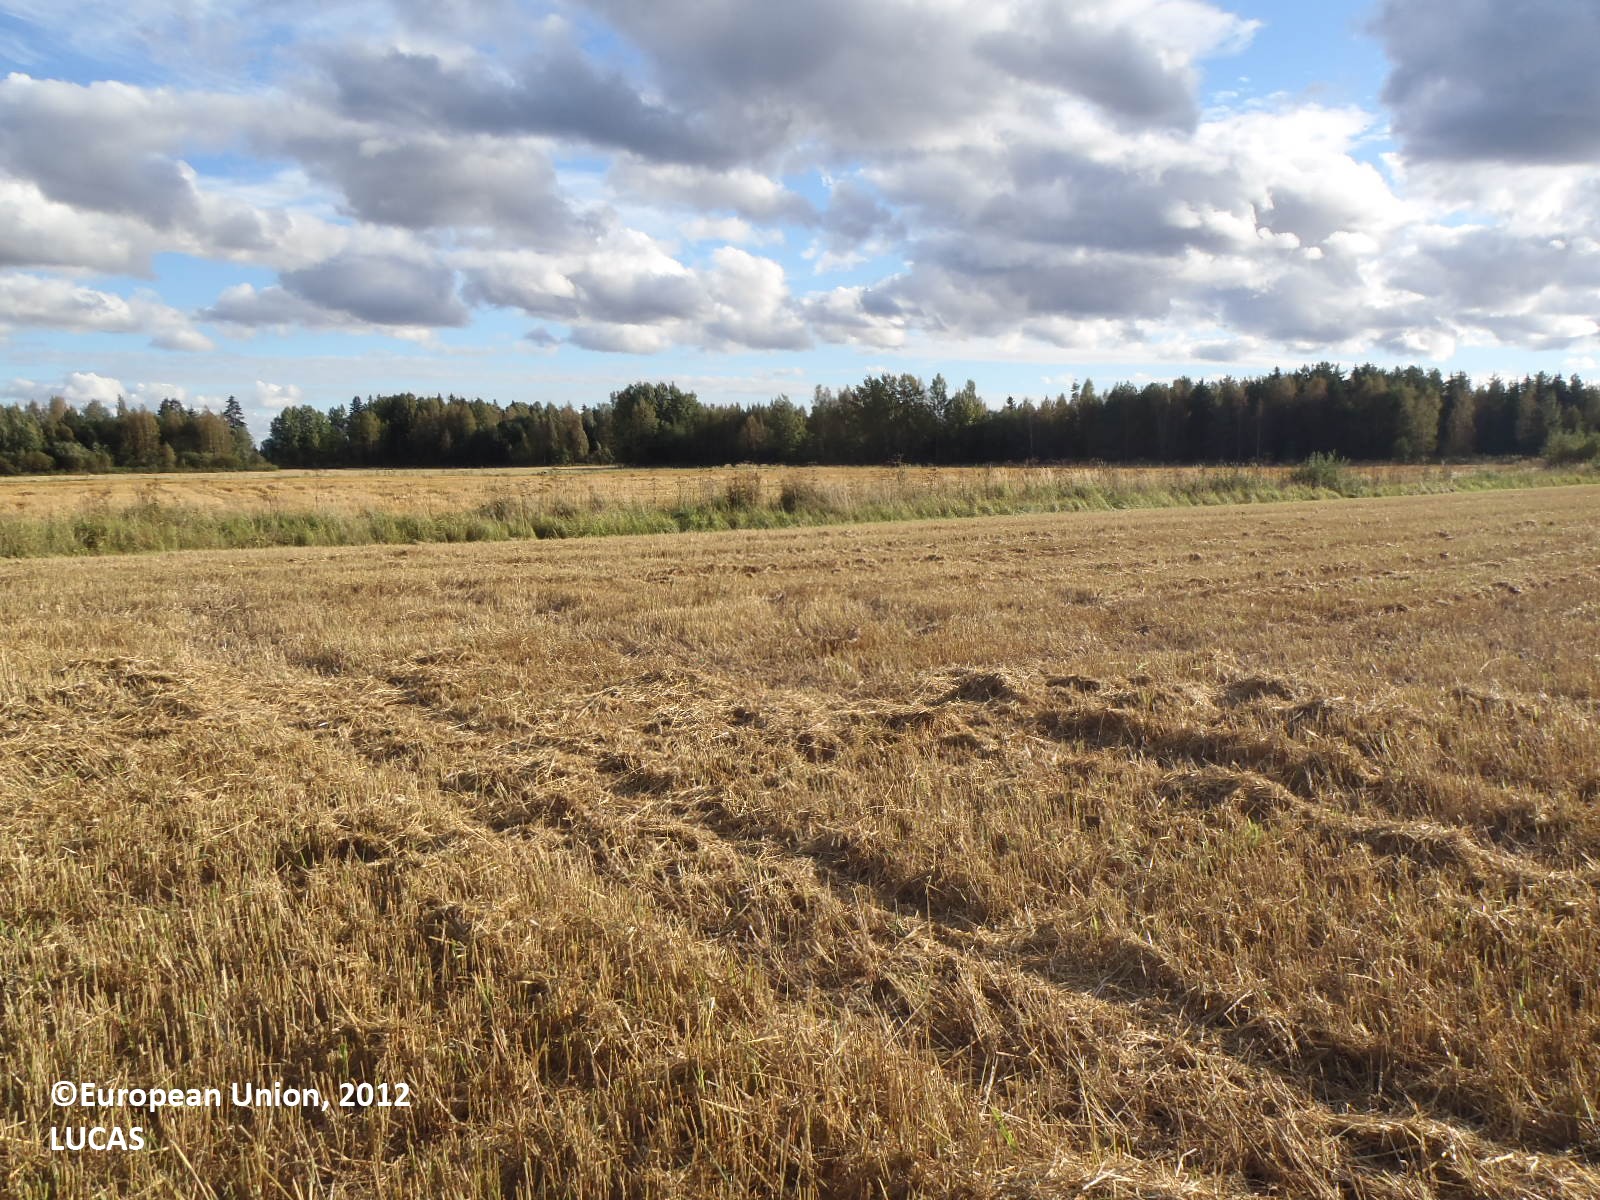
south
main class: Cropland
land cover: Barley
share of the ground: > 75 %
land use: Agriculture (excluding fallow land and kitchen gardens)
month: September
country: FI
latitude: 61.3189
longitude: 22.5235
